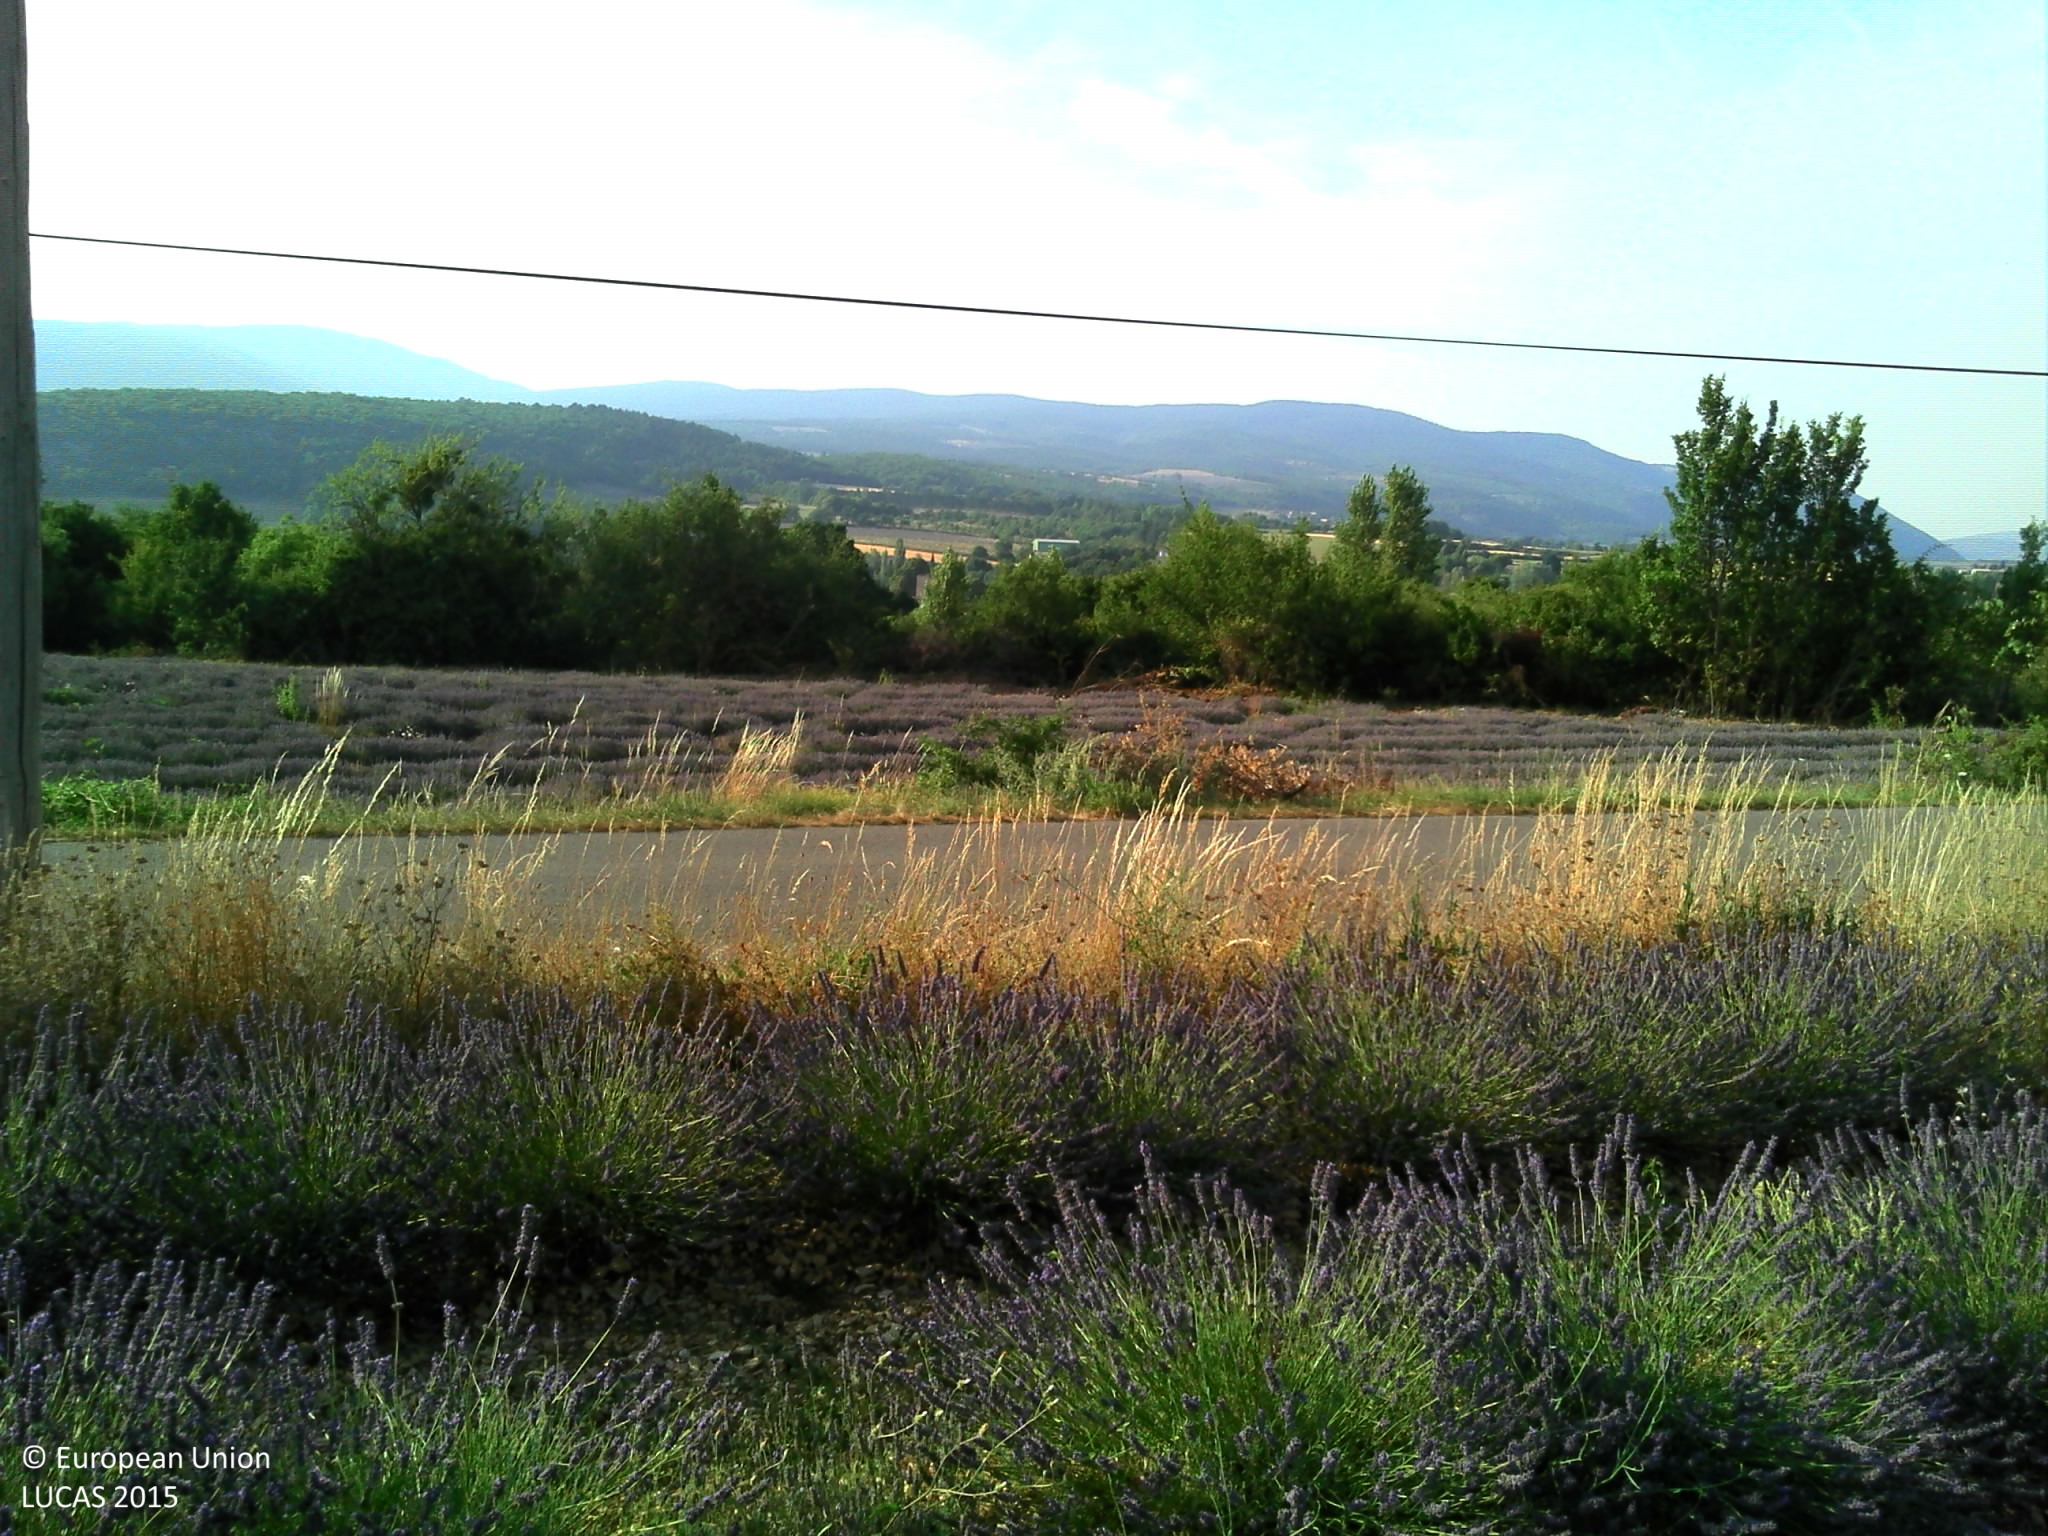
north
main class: Cropland
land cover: Permanent industrial crops
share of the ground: > 75 %
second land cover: Other bare soil
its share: > 75 %
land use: Agriculture (excluding fallow land and kitchen gardens)
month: July
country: FR
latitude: 44.0860
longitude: 5.3997
